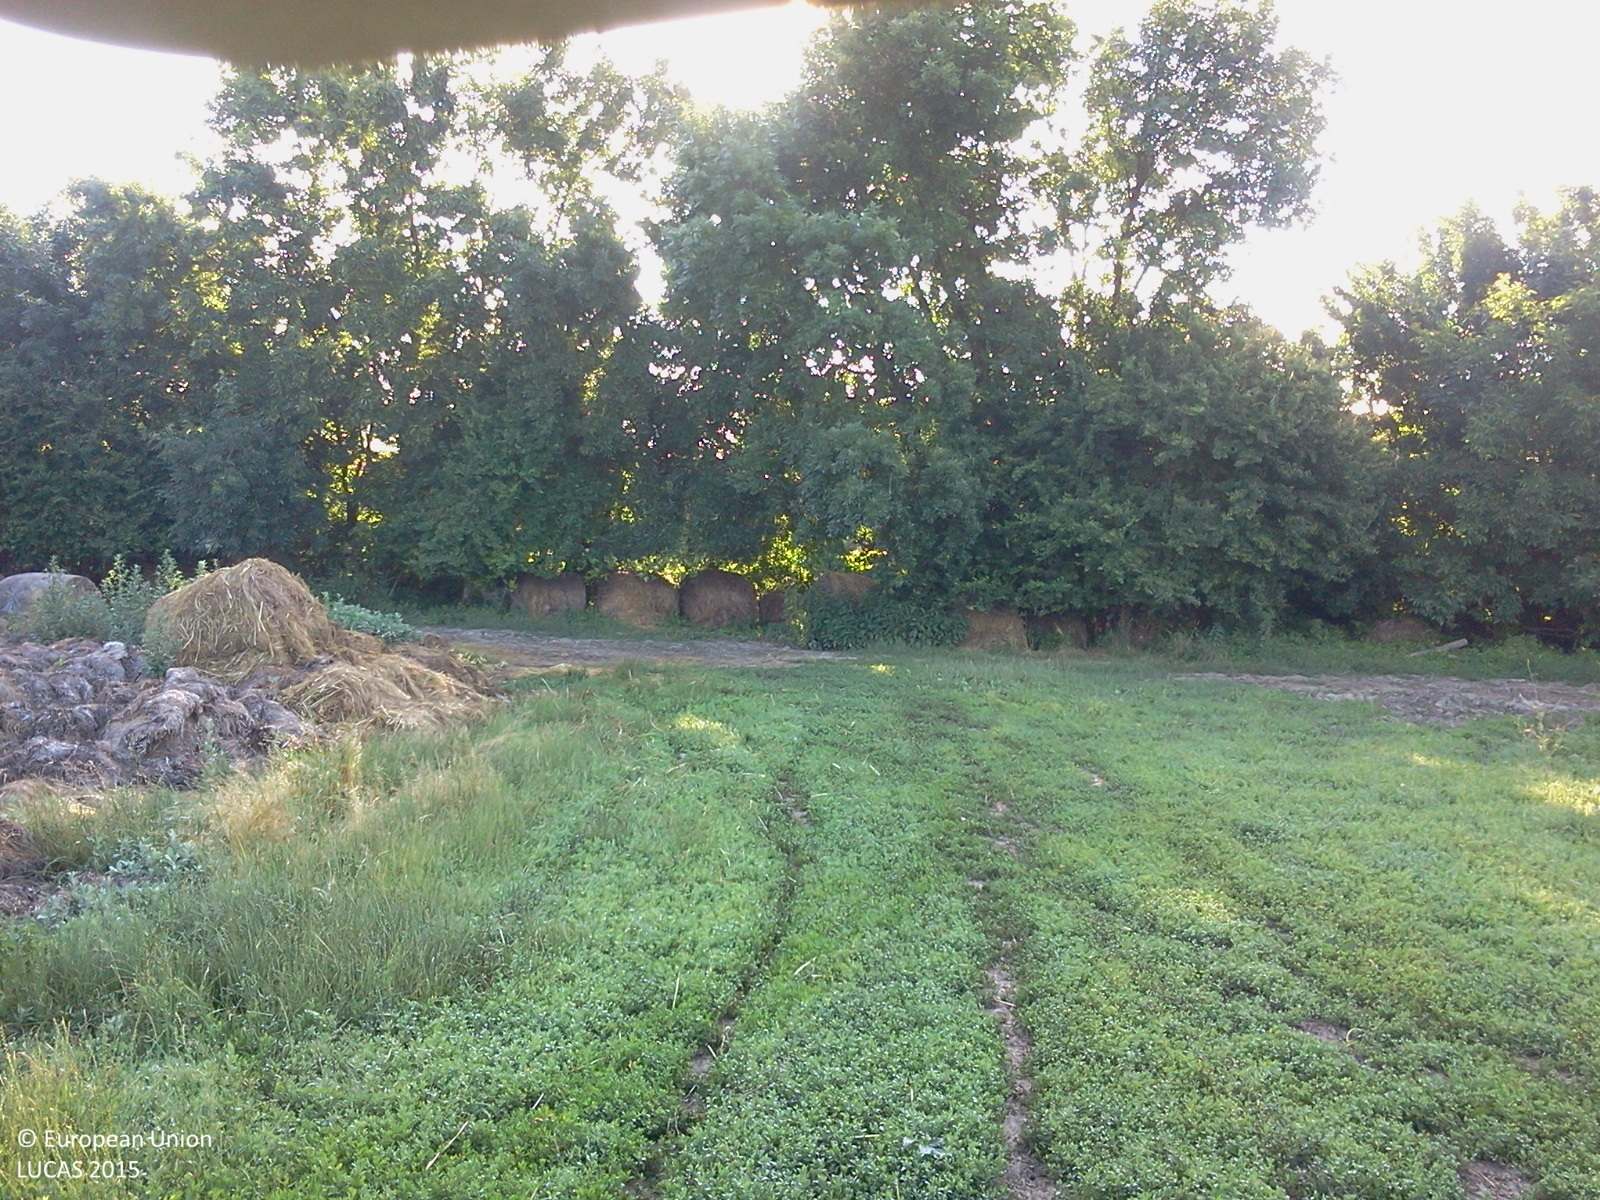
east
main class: Grassland
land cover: Spontaneously vegetated surfaces
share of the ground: > 75 %
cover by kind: herbaceous plants 100 %
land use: Agriculture (excluding fallow land and kitchen gardens)
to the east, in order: Tracks; Spontaneously vegetated surfaces; Broadleaved woodland; Paved roads, cycling and walking lanes; Grass margins; Artificial constructions in urban areas; Spontaneously vegetated surfaces; Broadleaved woodland; Tracks; Broadleaved woodland
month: June
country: HU
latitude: 46.7291
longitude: 17.1093
